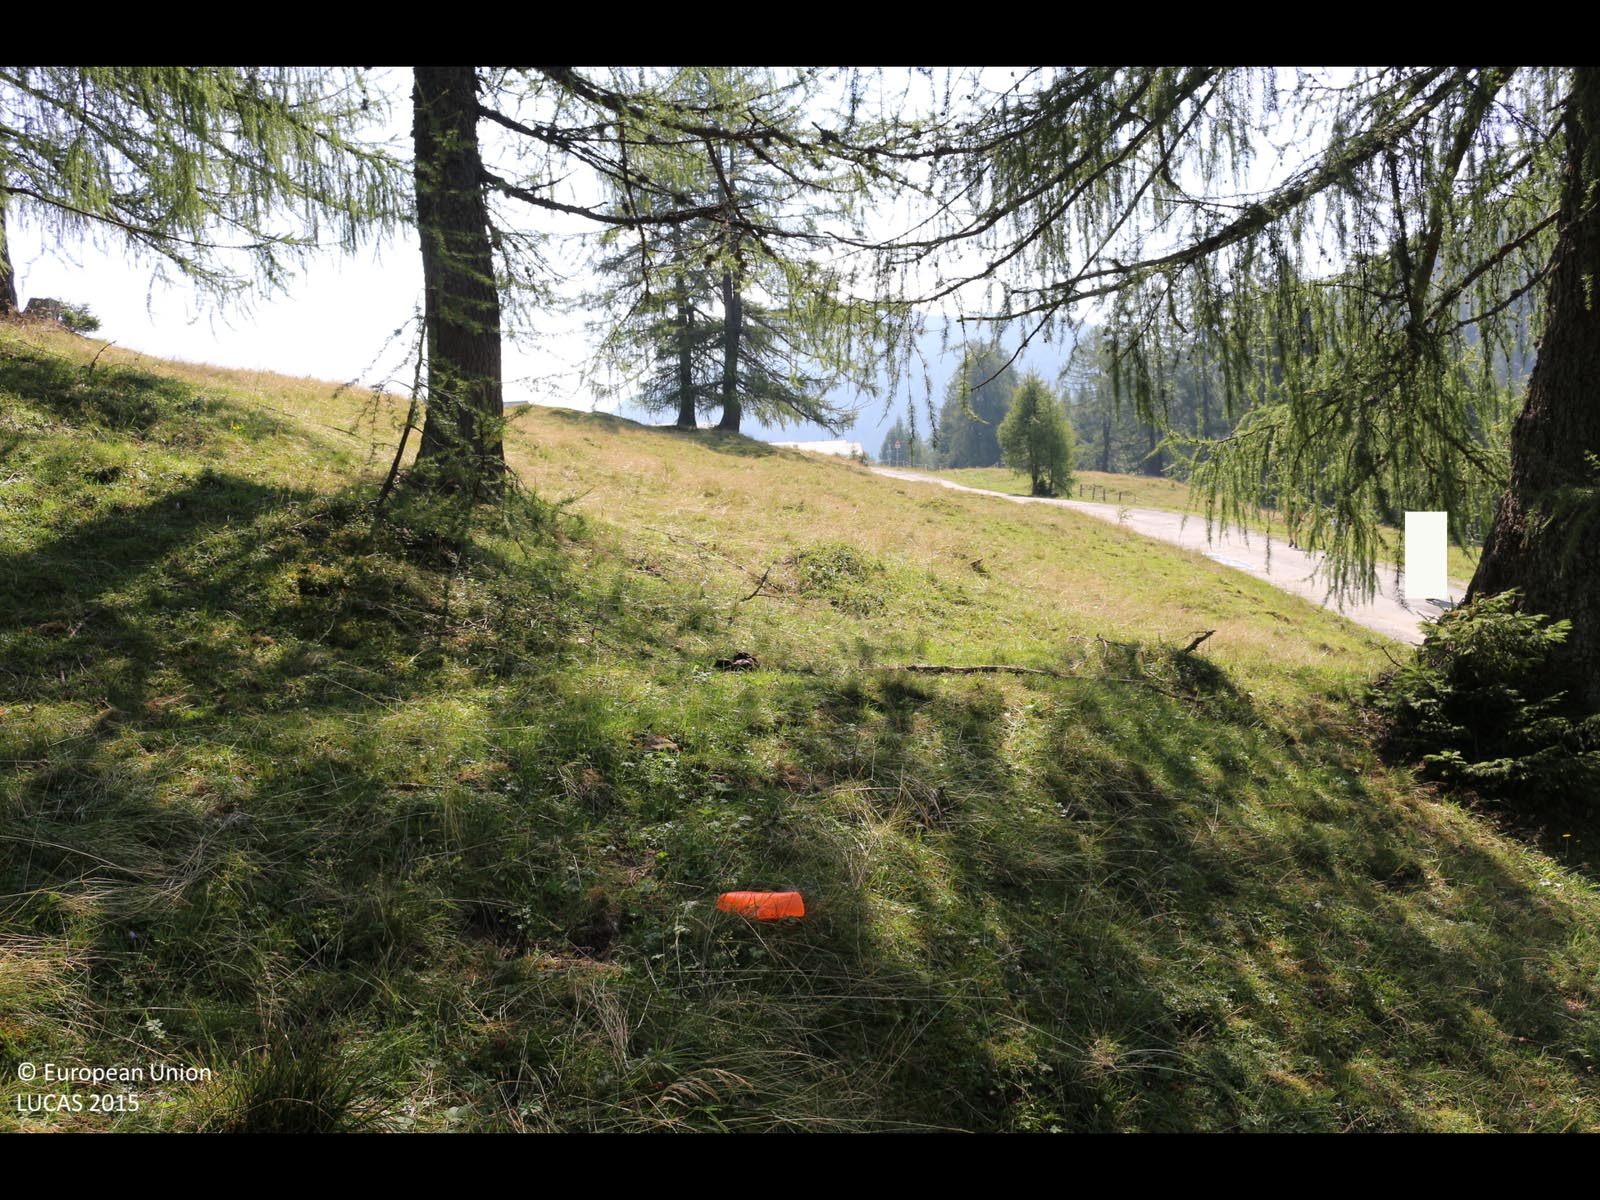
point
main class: Woodland
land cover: Other coniferous woodland
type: alpine coniferous forest
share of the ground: 50 - 75 %
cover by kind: coniferous forest trees 60 %, herbaceous plants 40 %
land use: Forestry
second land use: Agriculture (excluding fallow land and kitchen gardens)
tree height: > 5 m
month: August
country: AT
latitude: 46.5863
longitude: 13.3773
